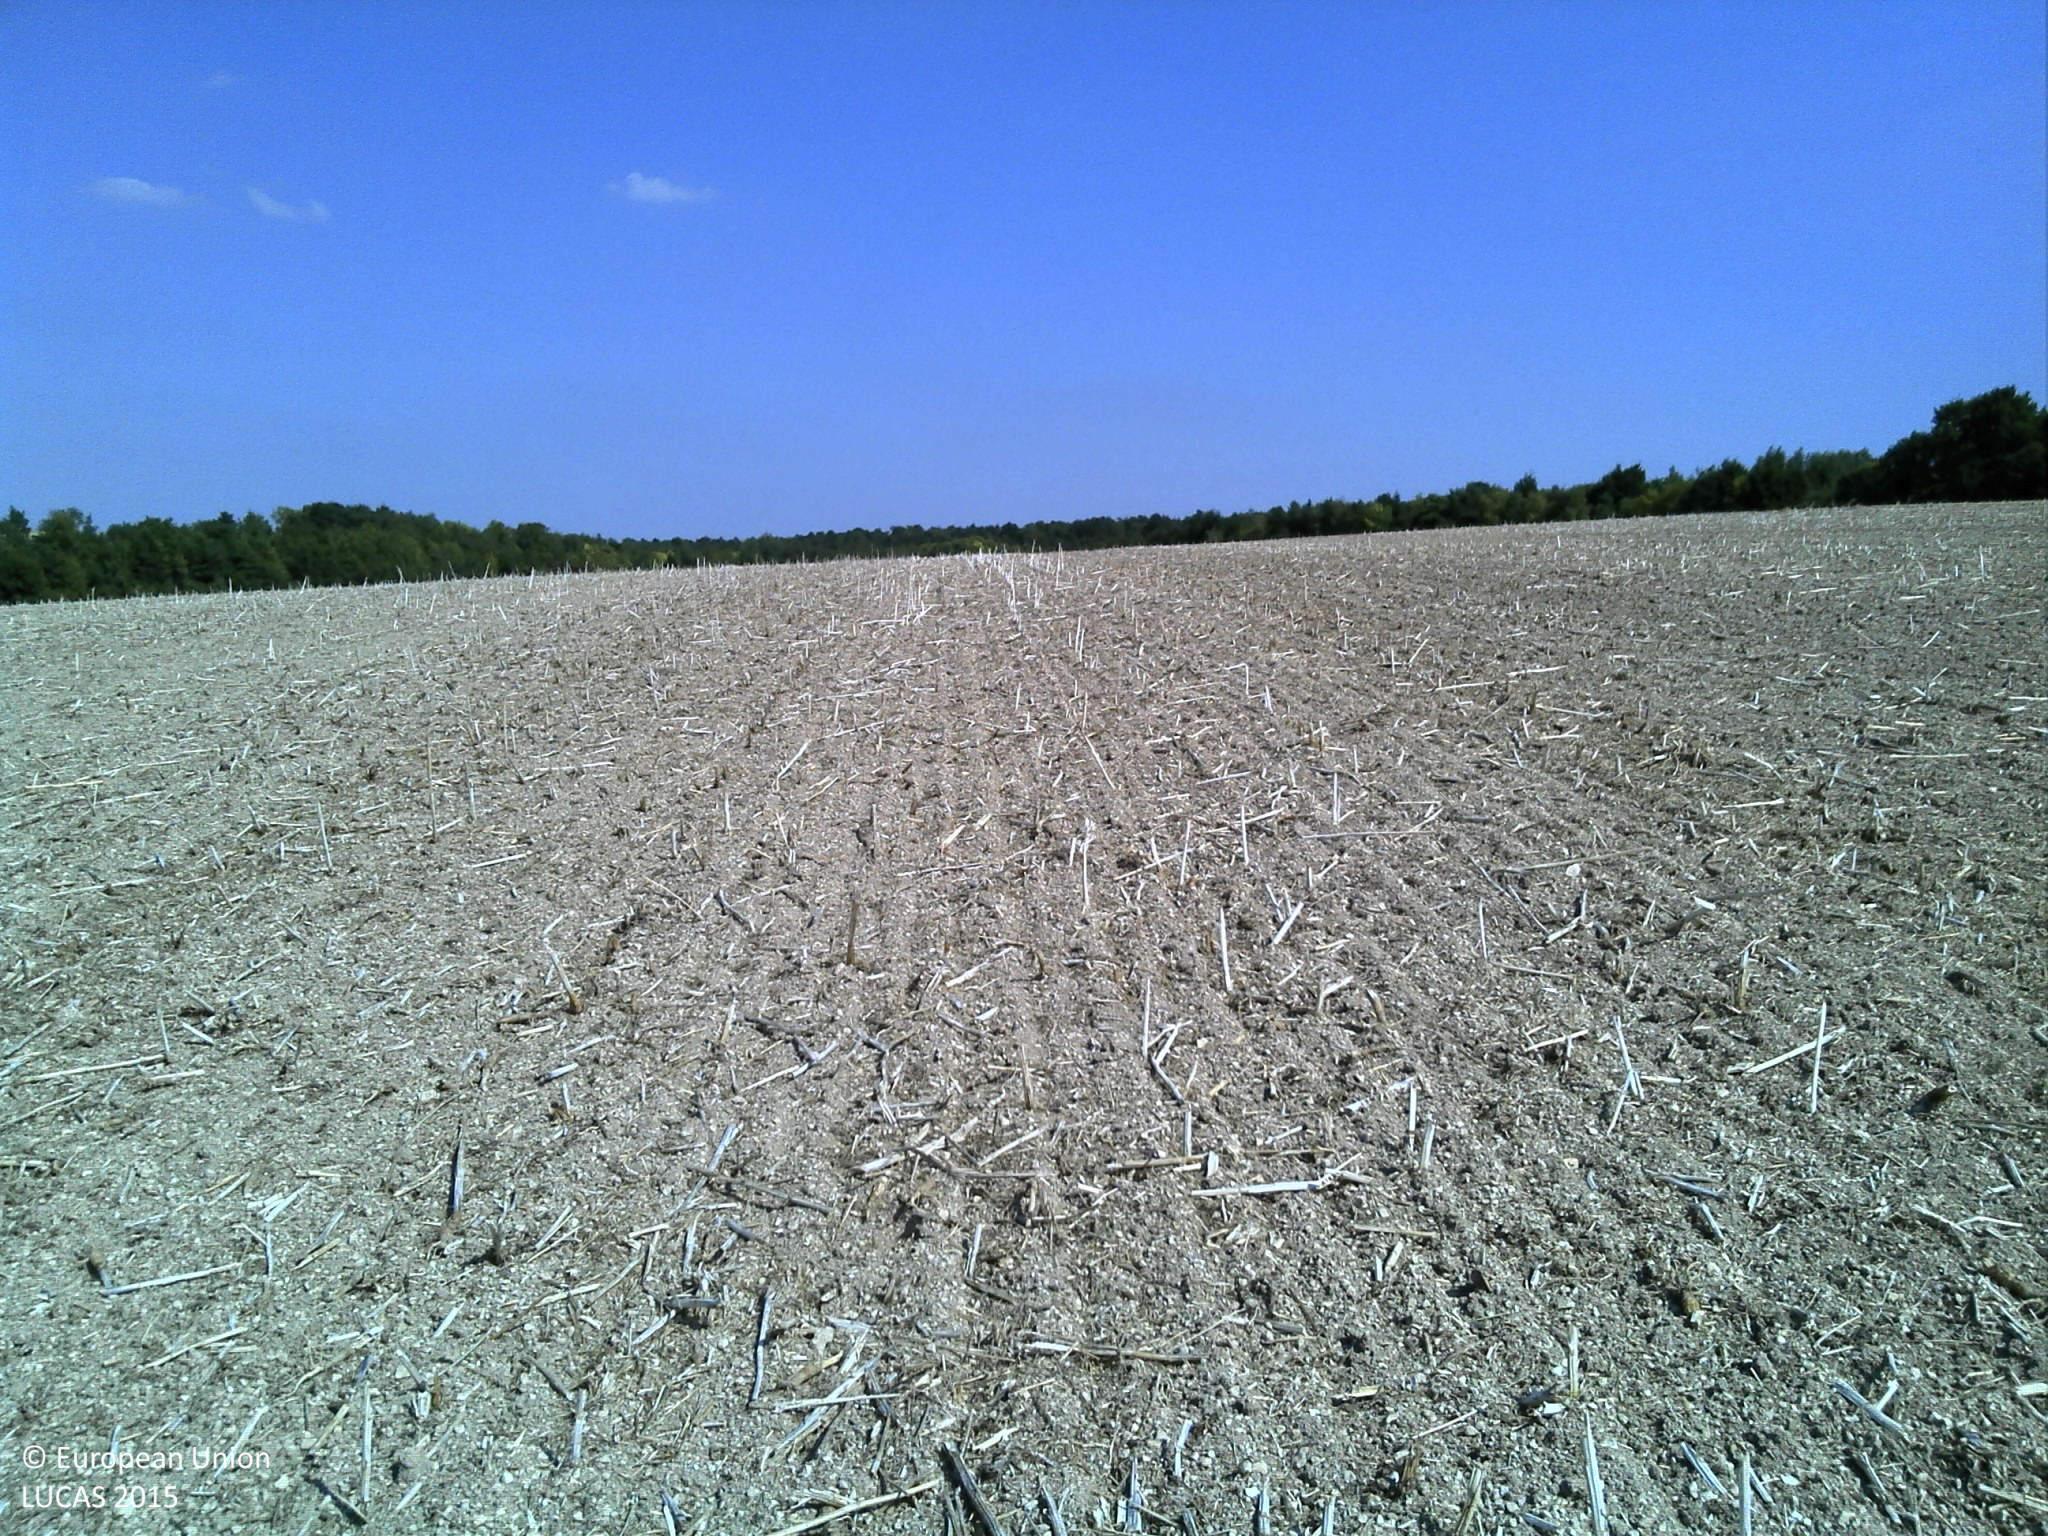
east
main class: Cropland
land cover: Rape and turnip rape
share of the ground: > 75 %
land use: Agriculture (excluding fallow land and kitchen gardens)
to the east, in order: Rape and turnip rape
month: August
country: FR
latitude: 48.9429
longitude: 4.6861
